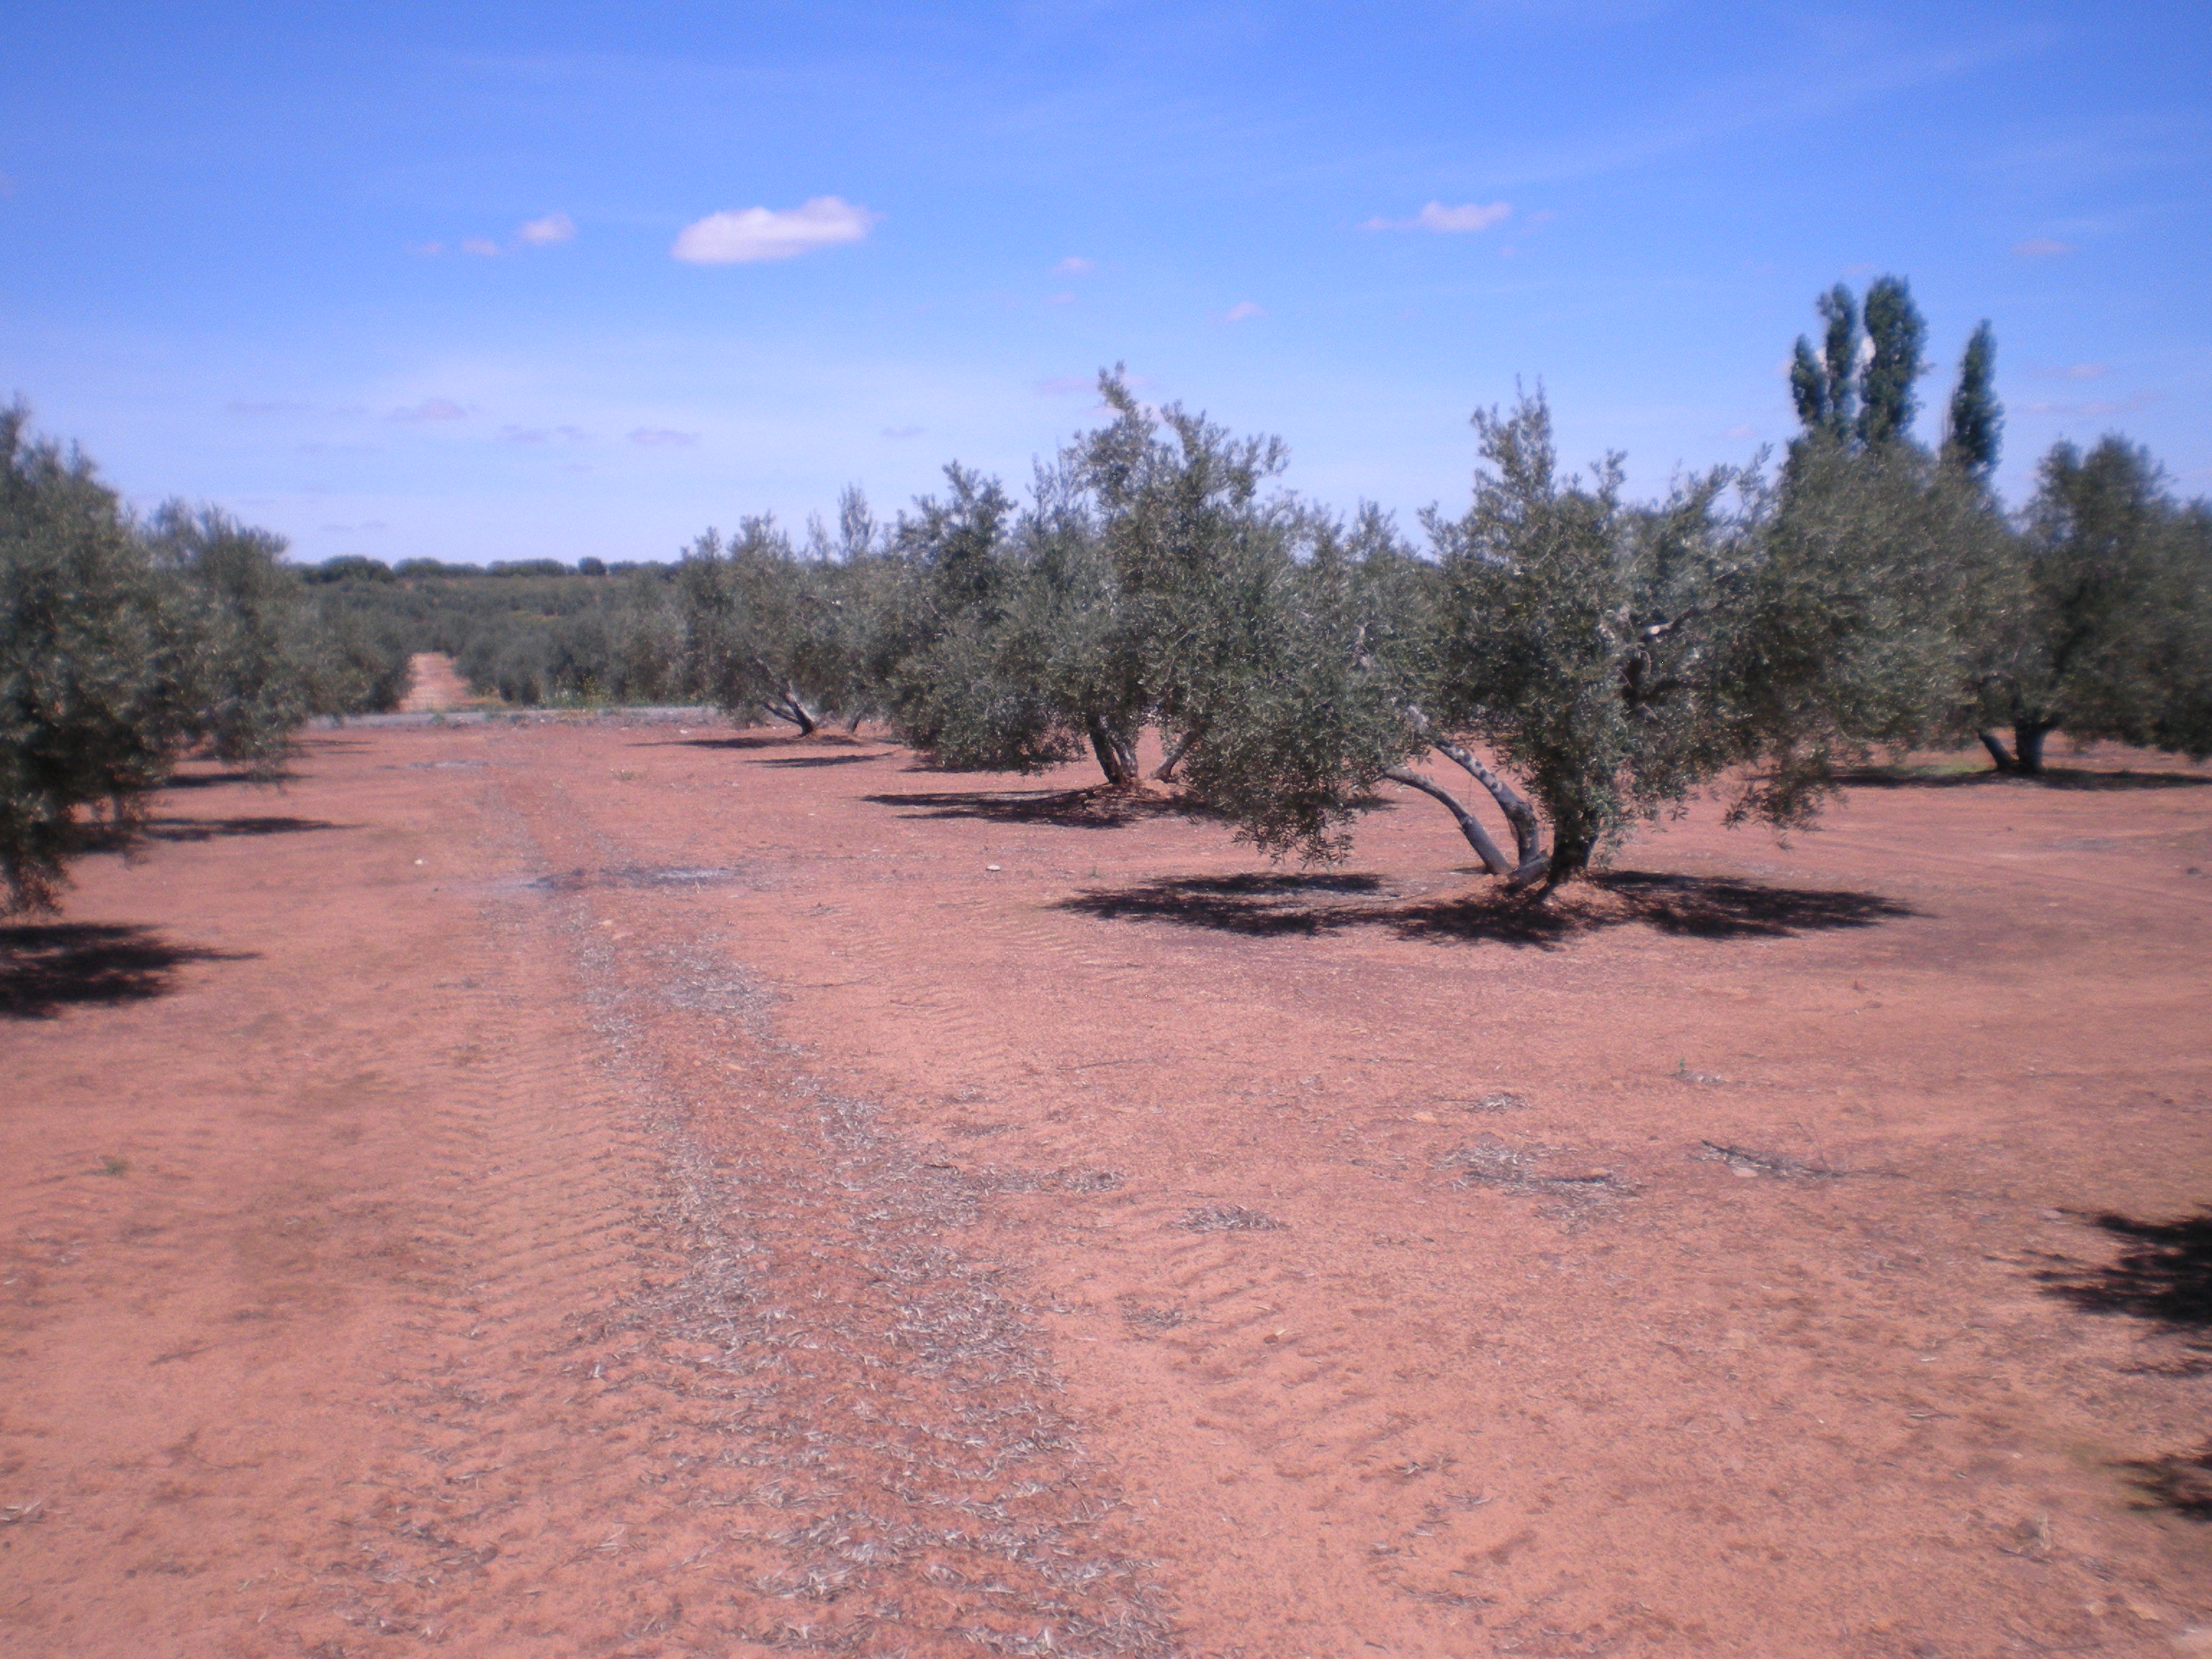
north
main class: Cropland
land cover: Olive groves
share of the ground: 25 - 50 %
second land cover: Other bare soil
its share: > 75 %
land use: Agriculture (excluding fallow land and kitchen gardens)
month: April
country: ES
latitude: 38.5436
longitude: -2.9570
